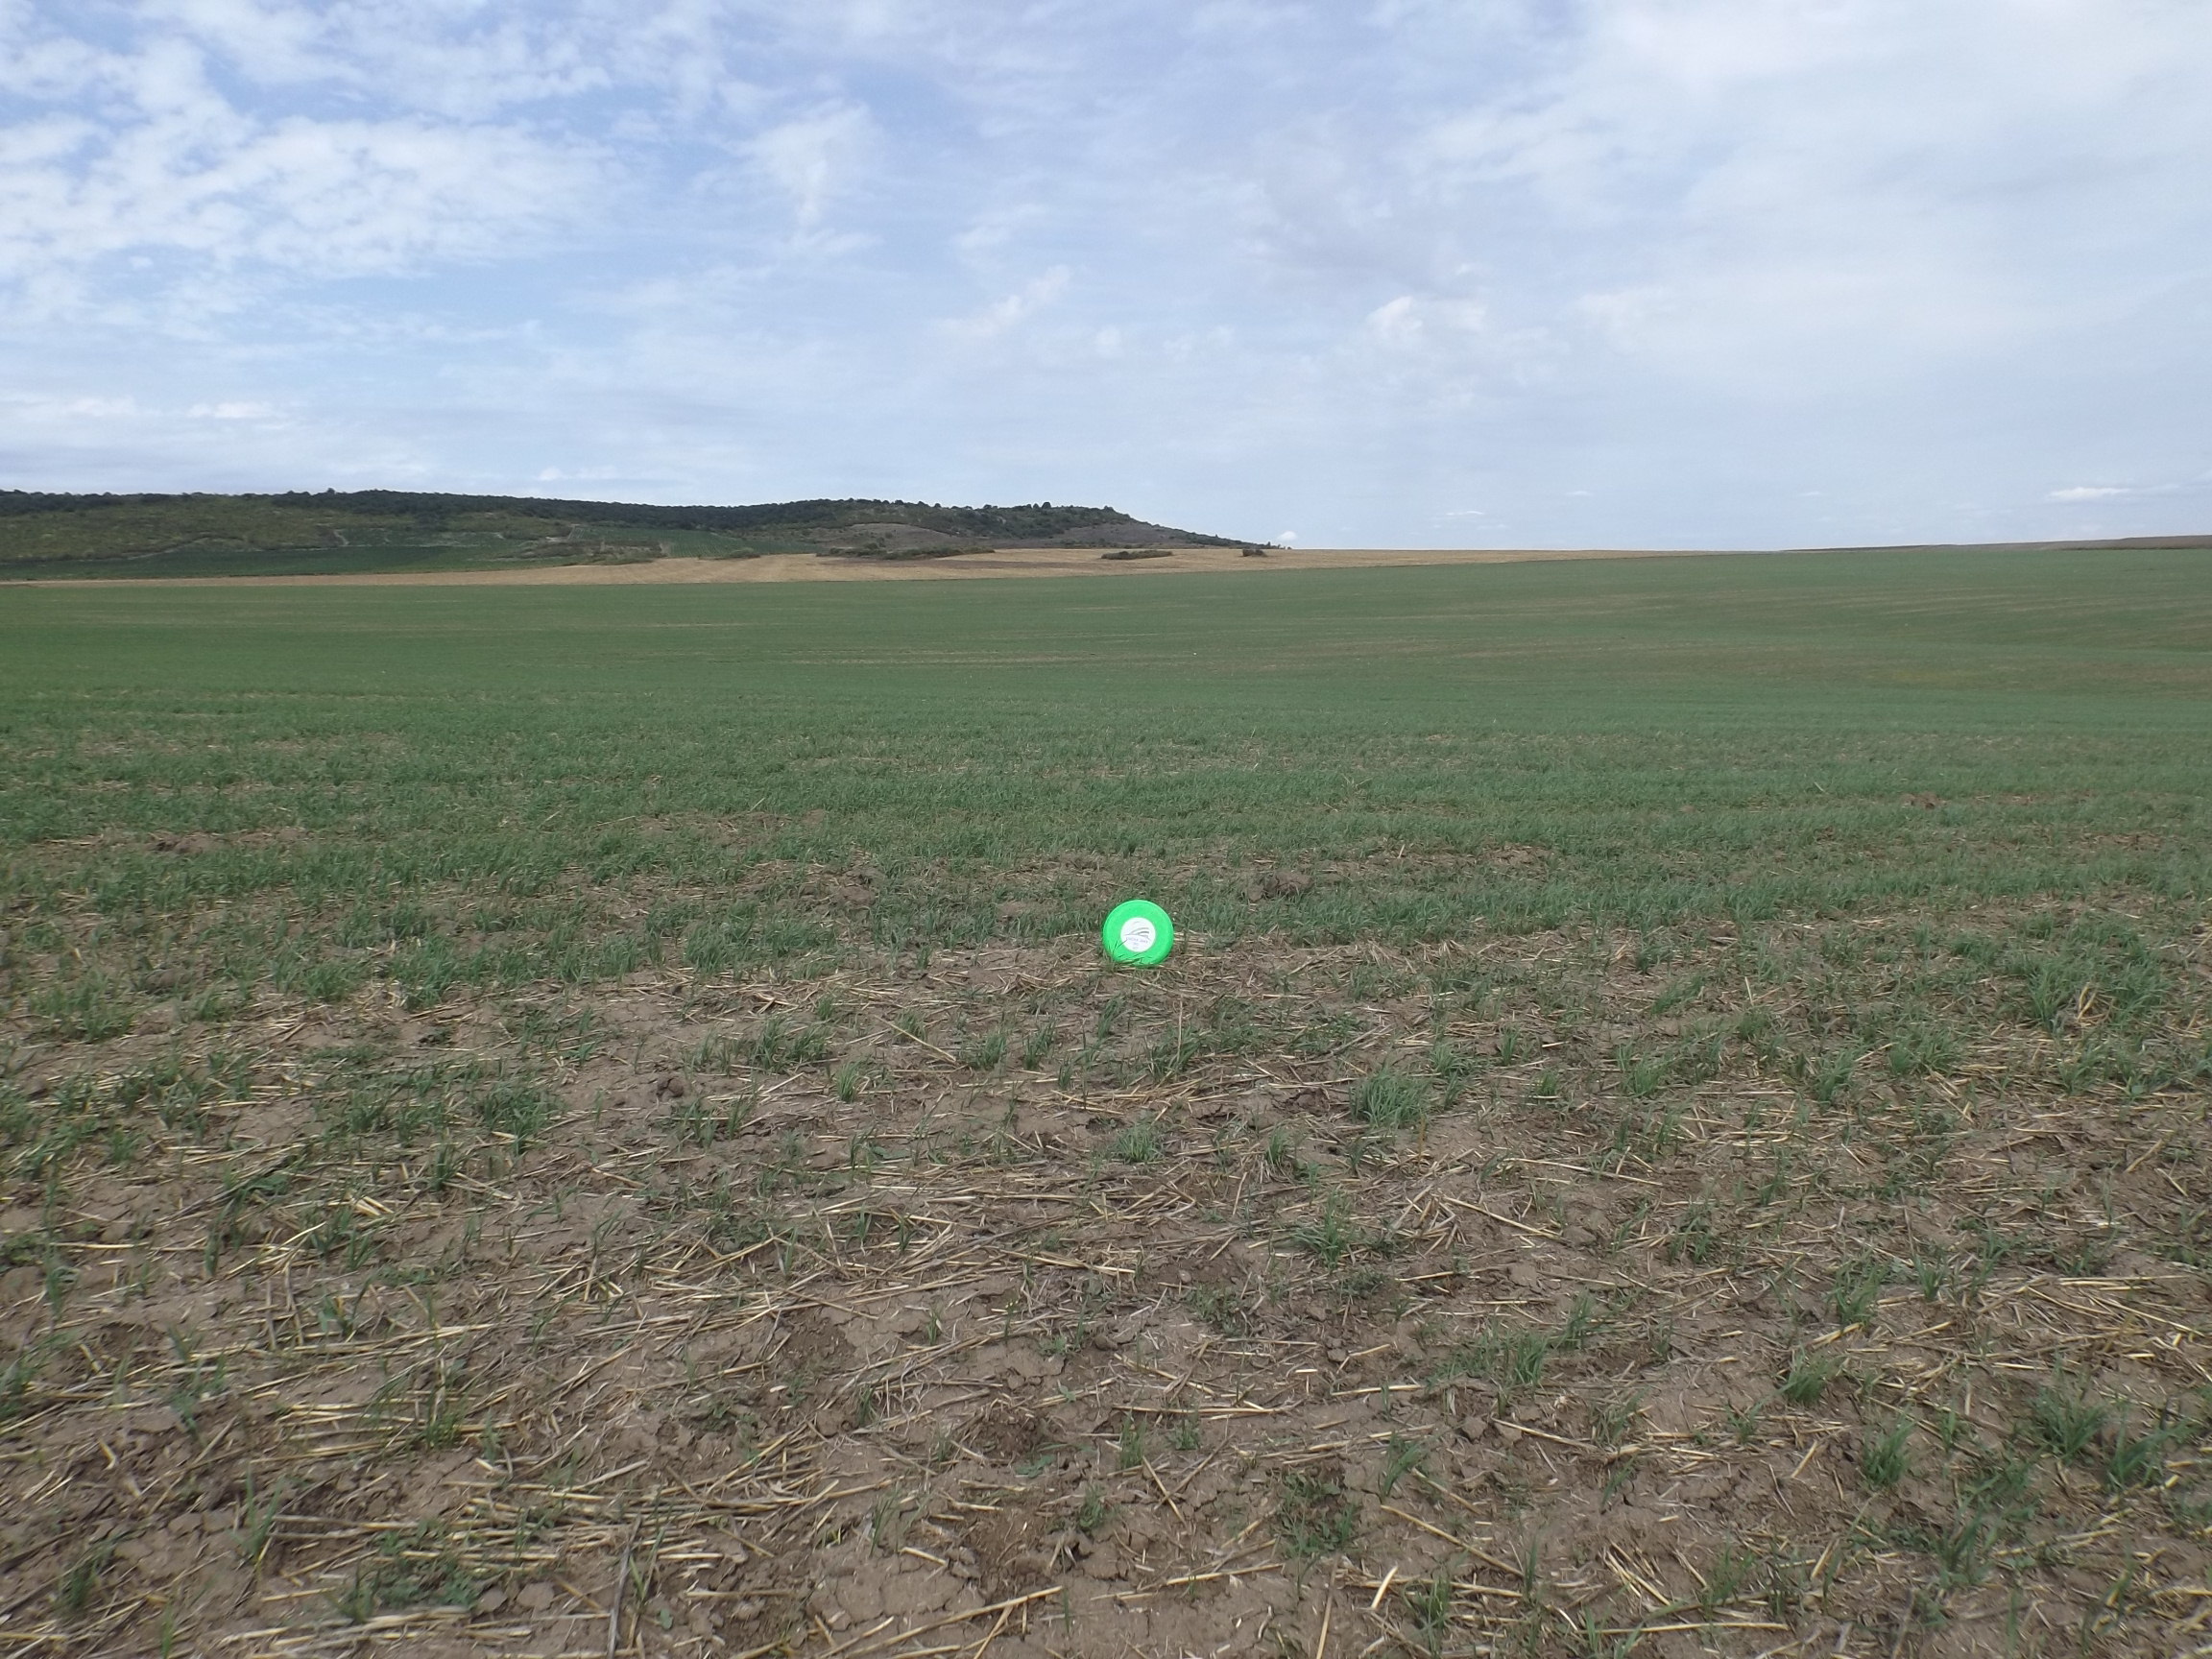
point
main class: Cropland
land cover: Common wheat
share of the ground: < 10 %
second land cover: Spontaneously vegetated surfaces
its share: 10 - 25 %
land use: Agriculture (excluding fallow land and kitchen gardens)
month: September
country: BG
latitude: 43.3306
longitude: 27.3795
